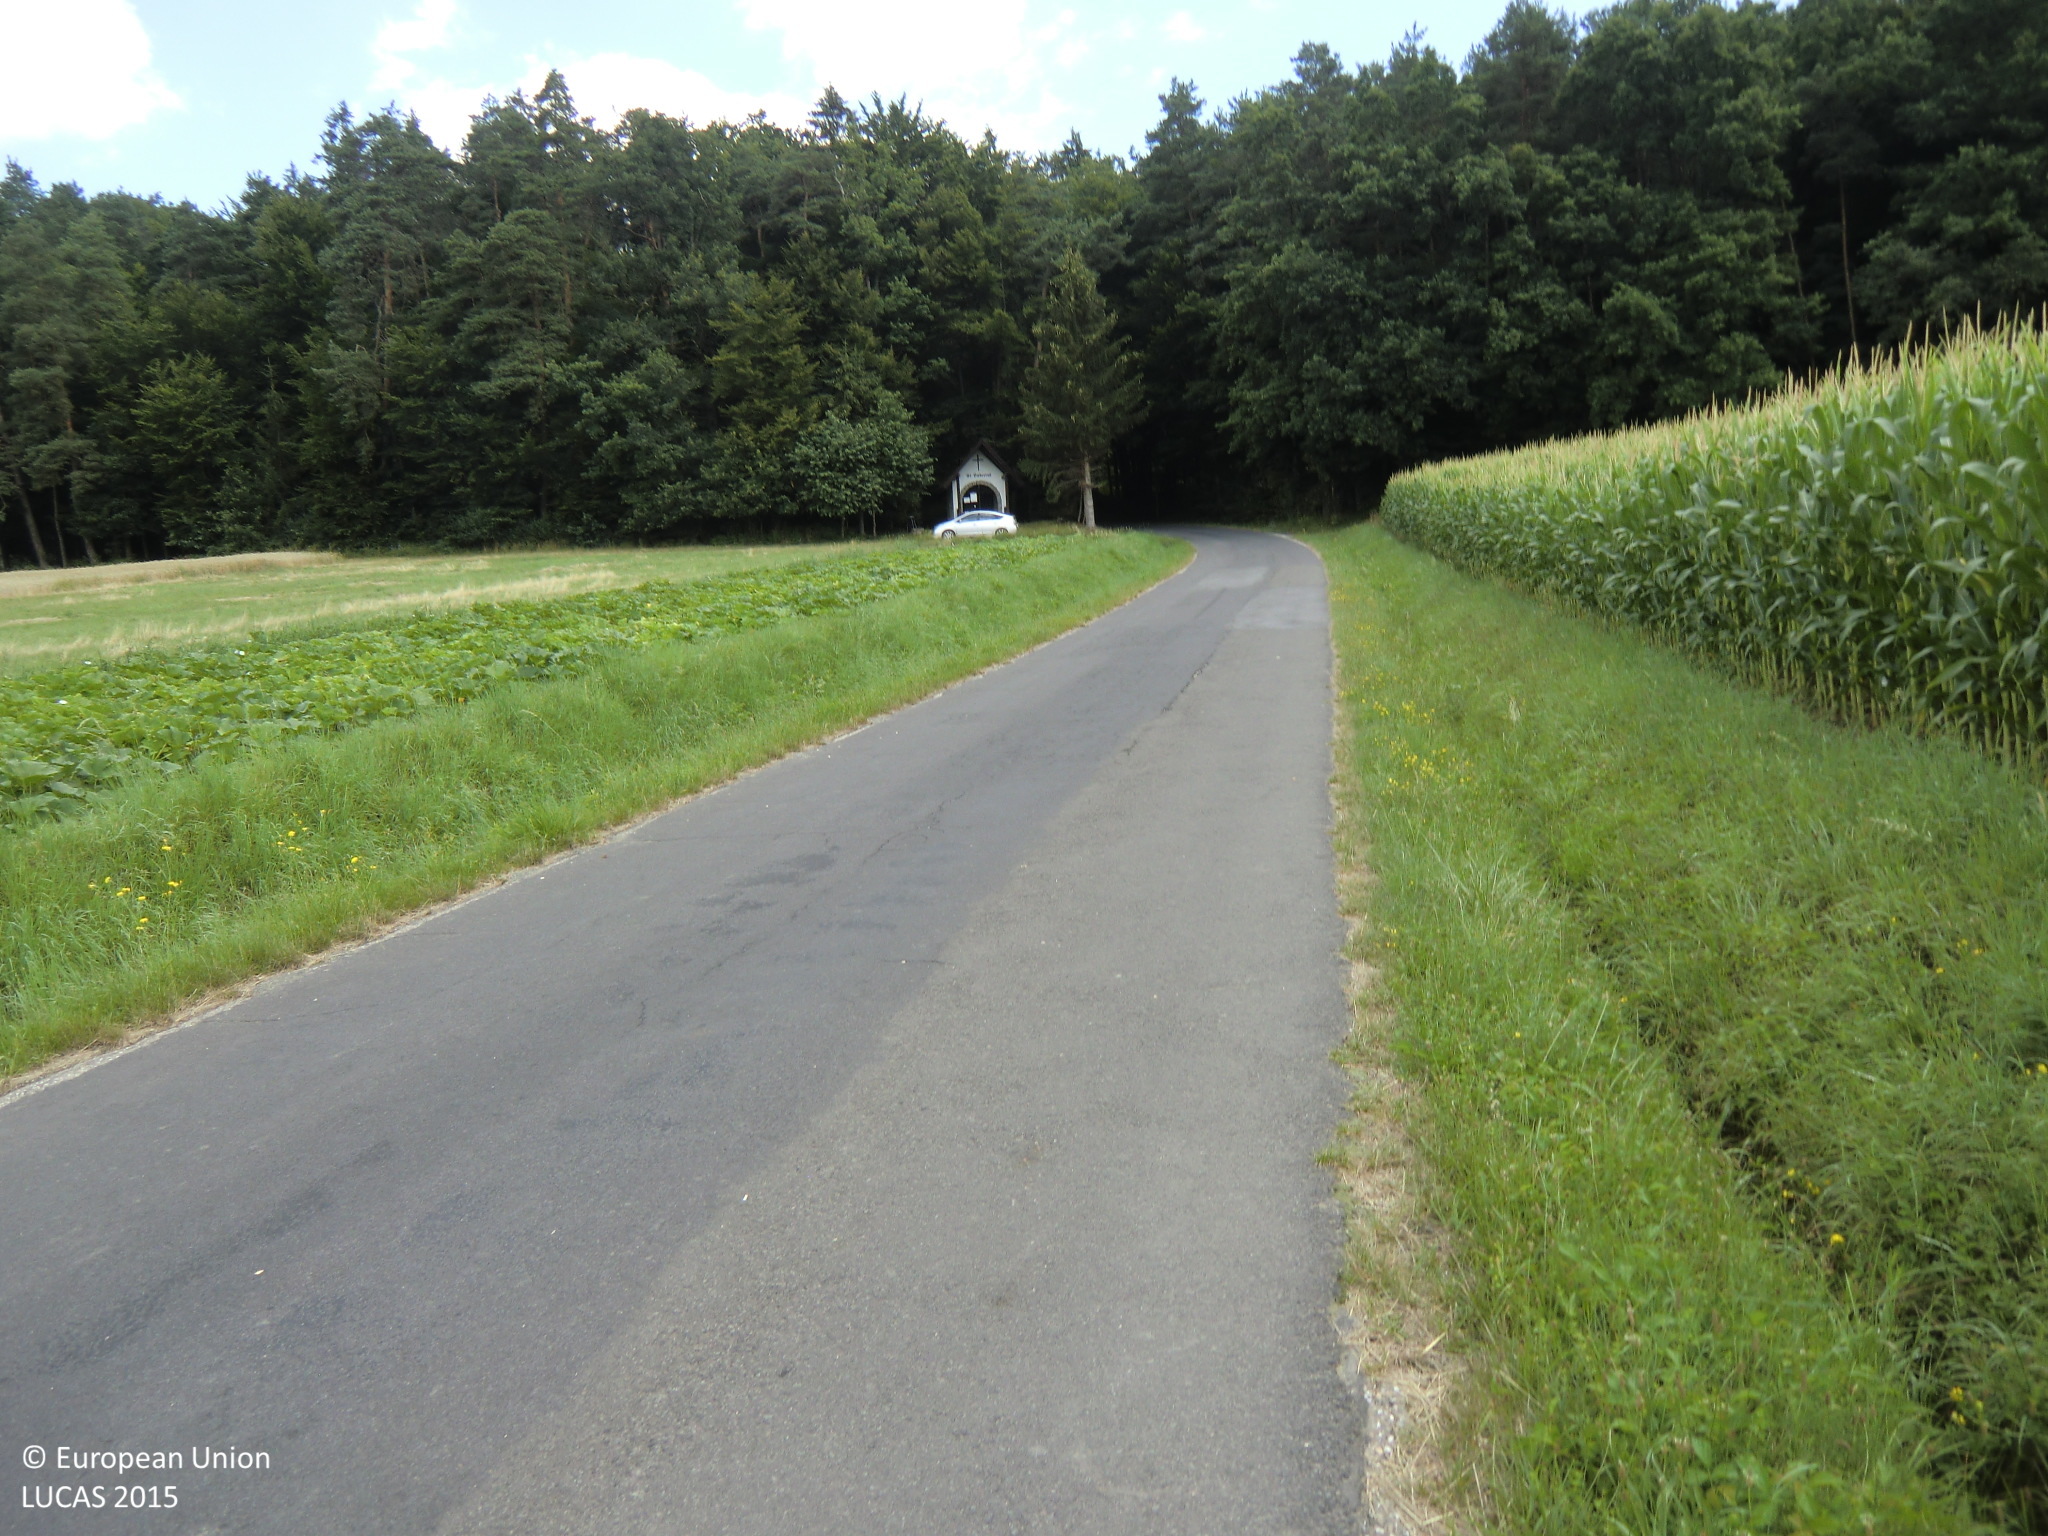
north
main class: Cropland
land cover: Maize
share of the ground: > 75 %
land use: Agriculture (excluding fallow land and kitchen gardens)
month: July
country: AT
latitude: 46.9515
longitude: 16.1373
